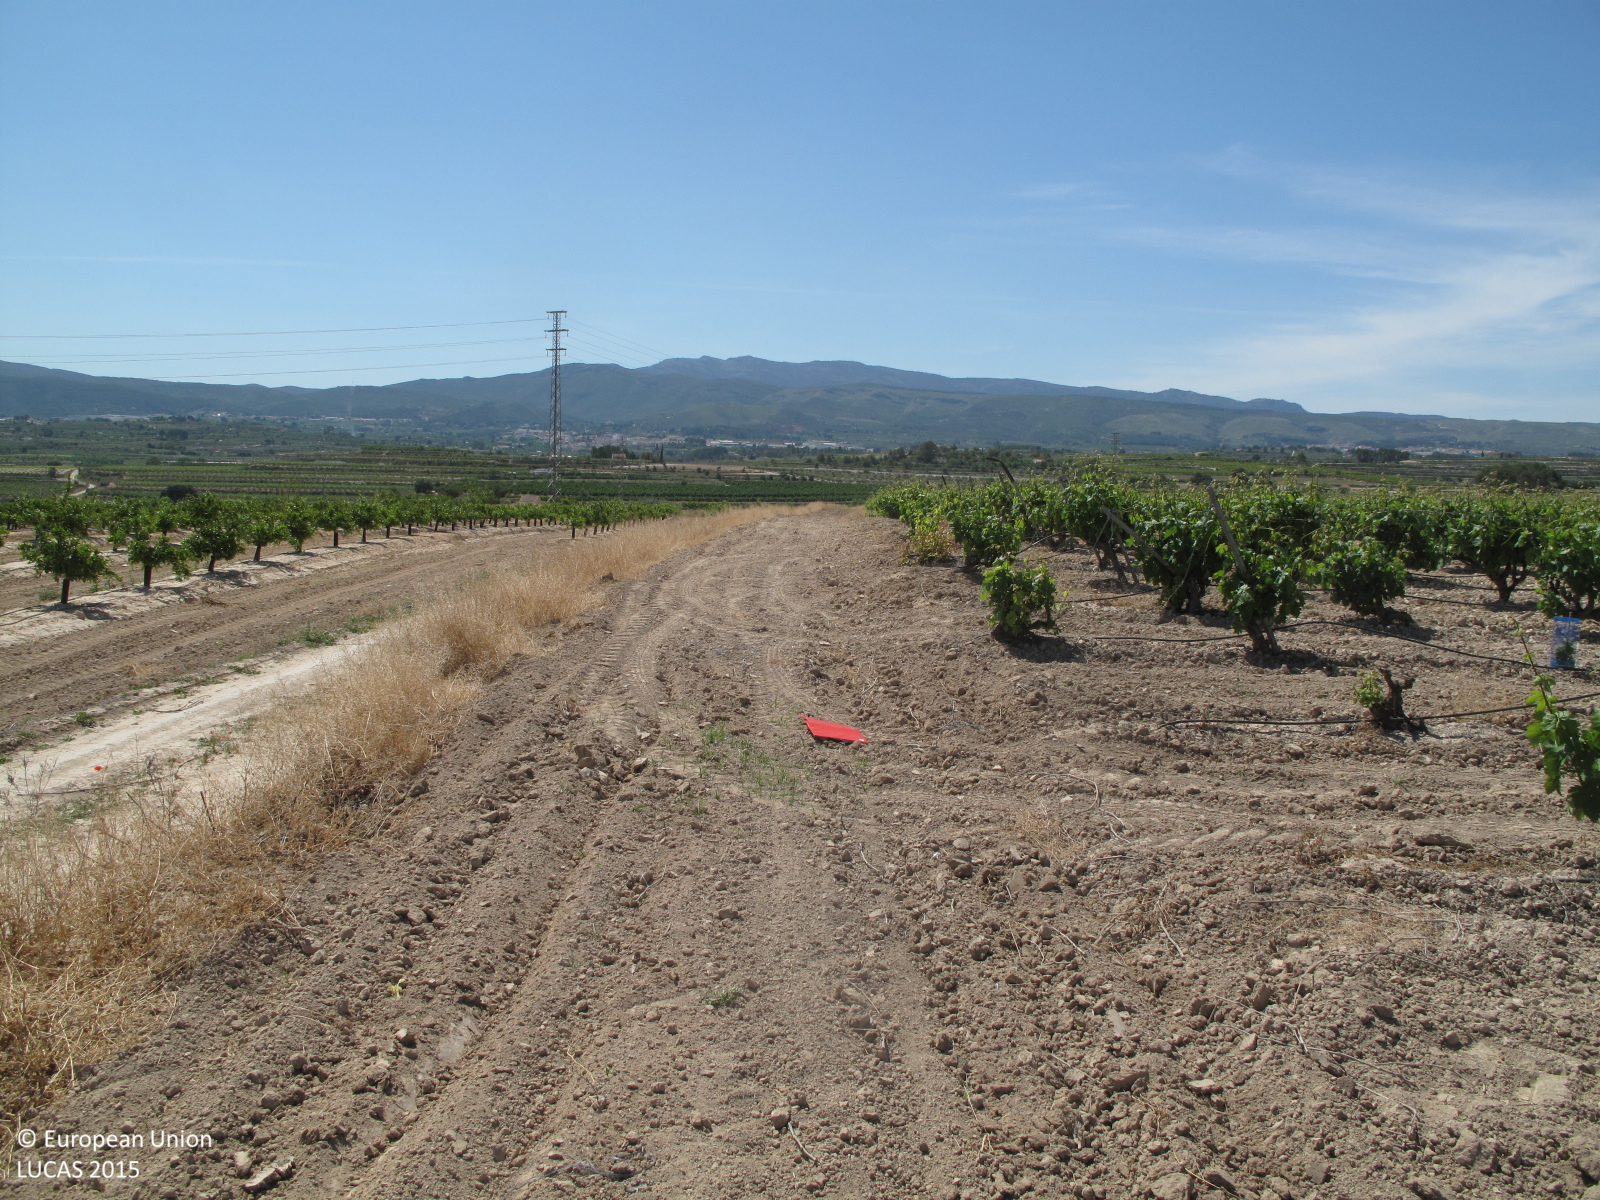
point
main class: Cropland
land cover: Vineyards
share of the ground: 25 - 50 %
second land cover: Other bare soil
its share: > 75 %
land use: Agriculture (excluding fallow land and kitchen gardens)
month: May
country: ES
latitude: 38.8772
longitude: -0.5386
